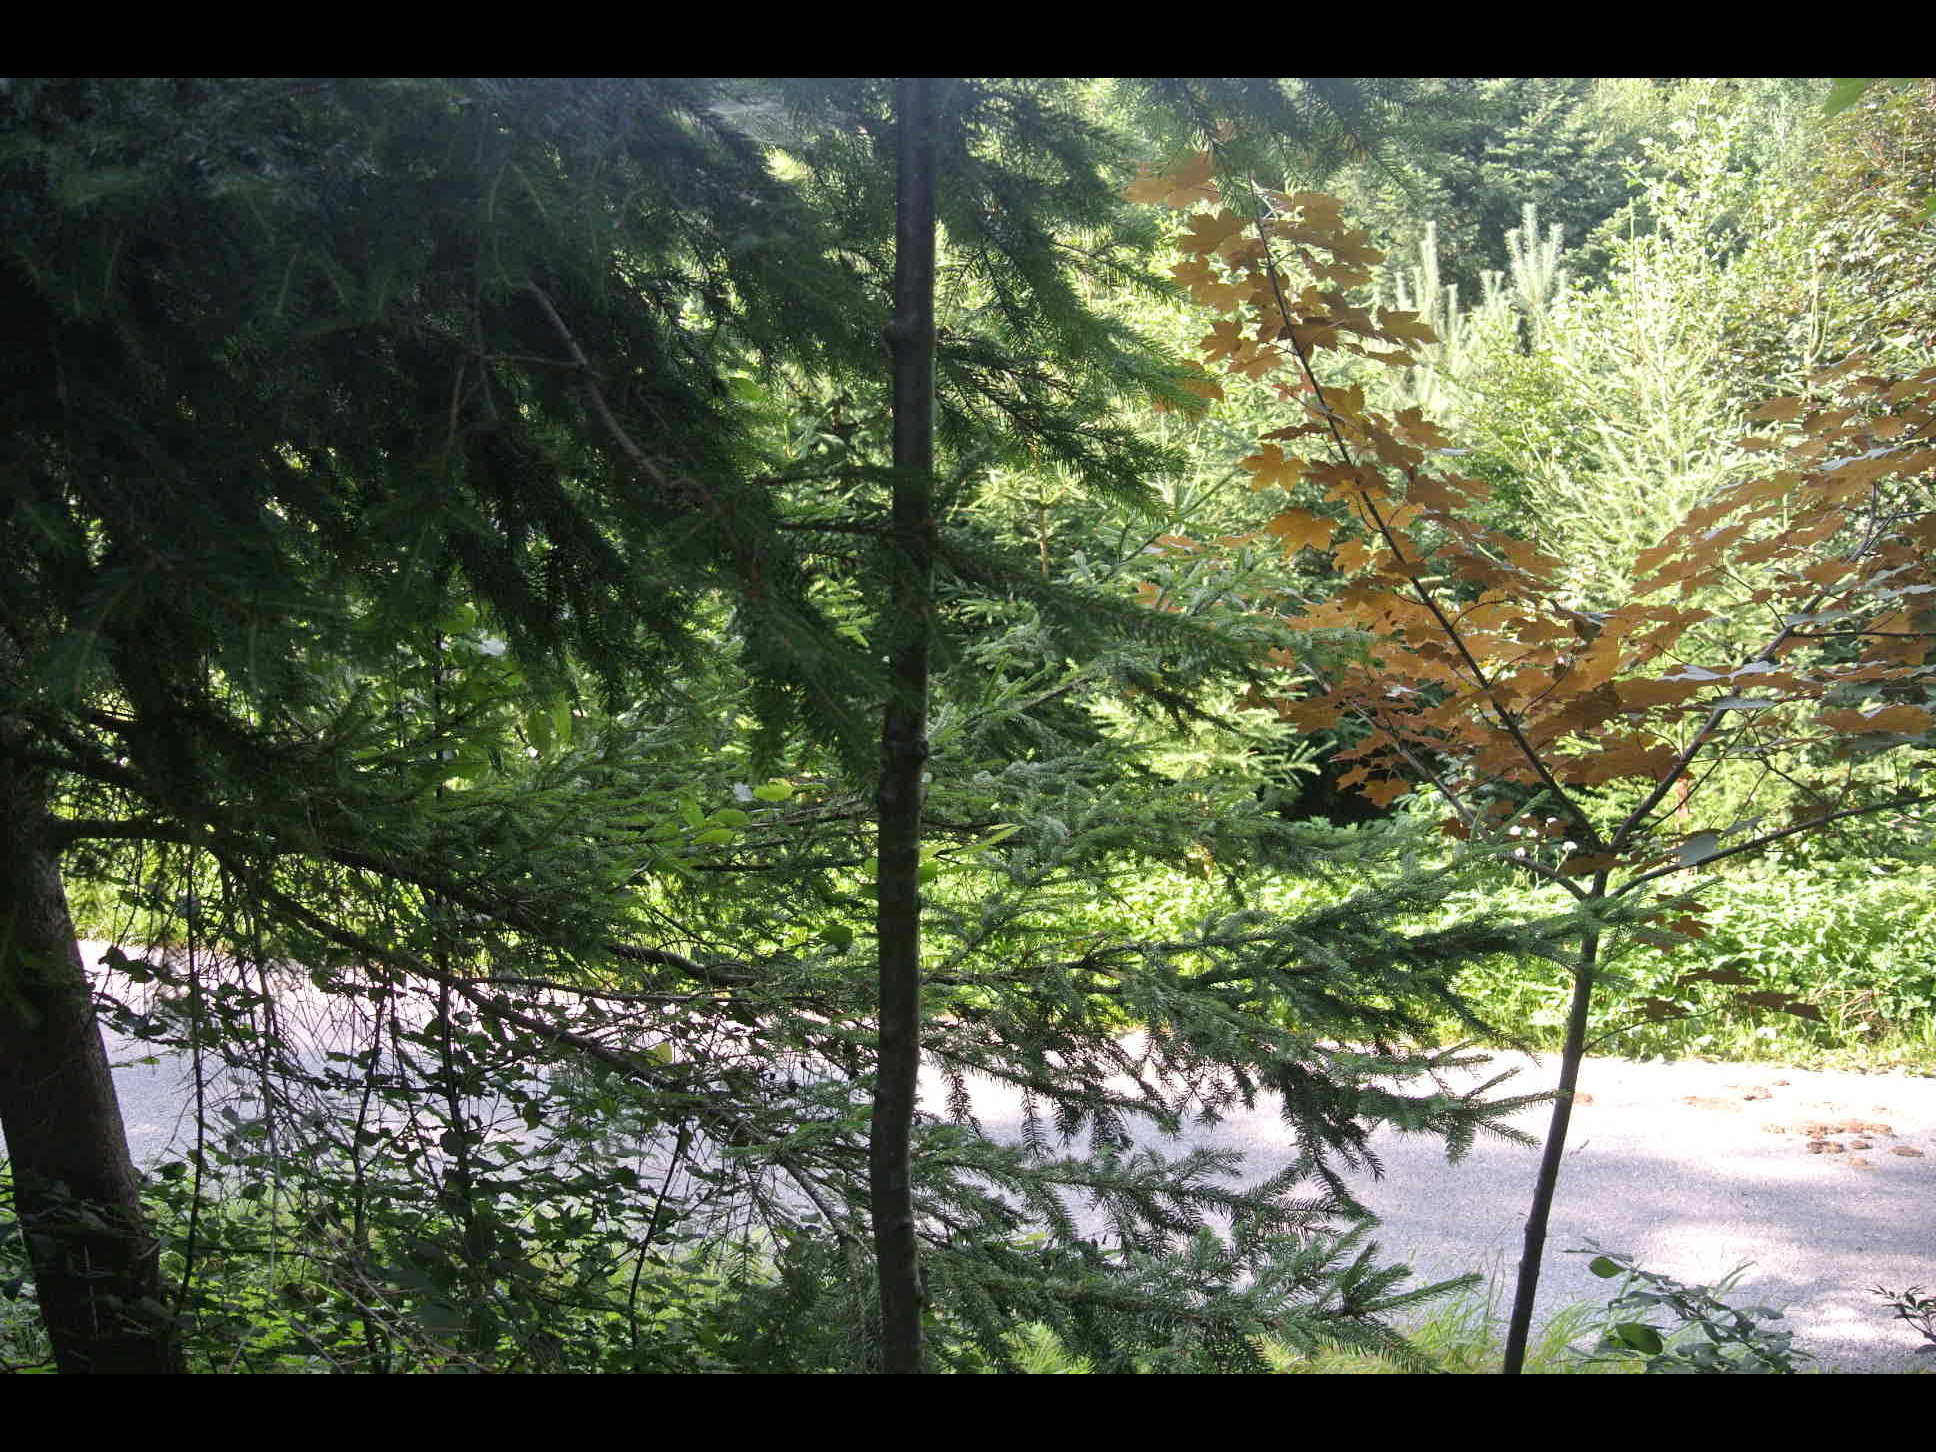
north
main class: Woodland
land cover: Spruce dominated mixed woodland
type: alpine coniferous forest
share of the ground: > 75 %
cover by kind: coniferous forest trees 70 %, broadleaved forest trees 30 %
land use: Forestry
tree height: > 5 m
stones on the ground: < 10 %
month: July
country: AT
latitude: 47.6568
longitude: 16.1144
